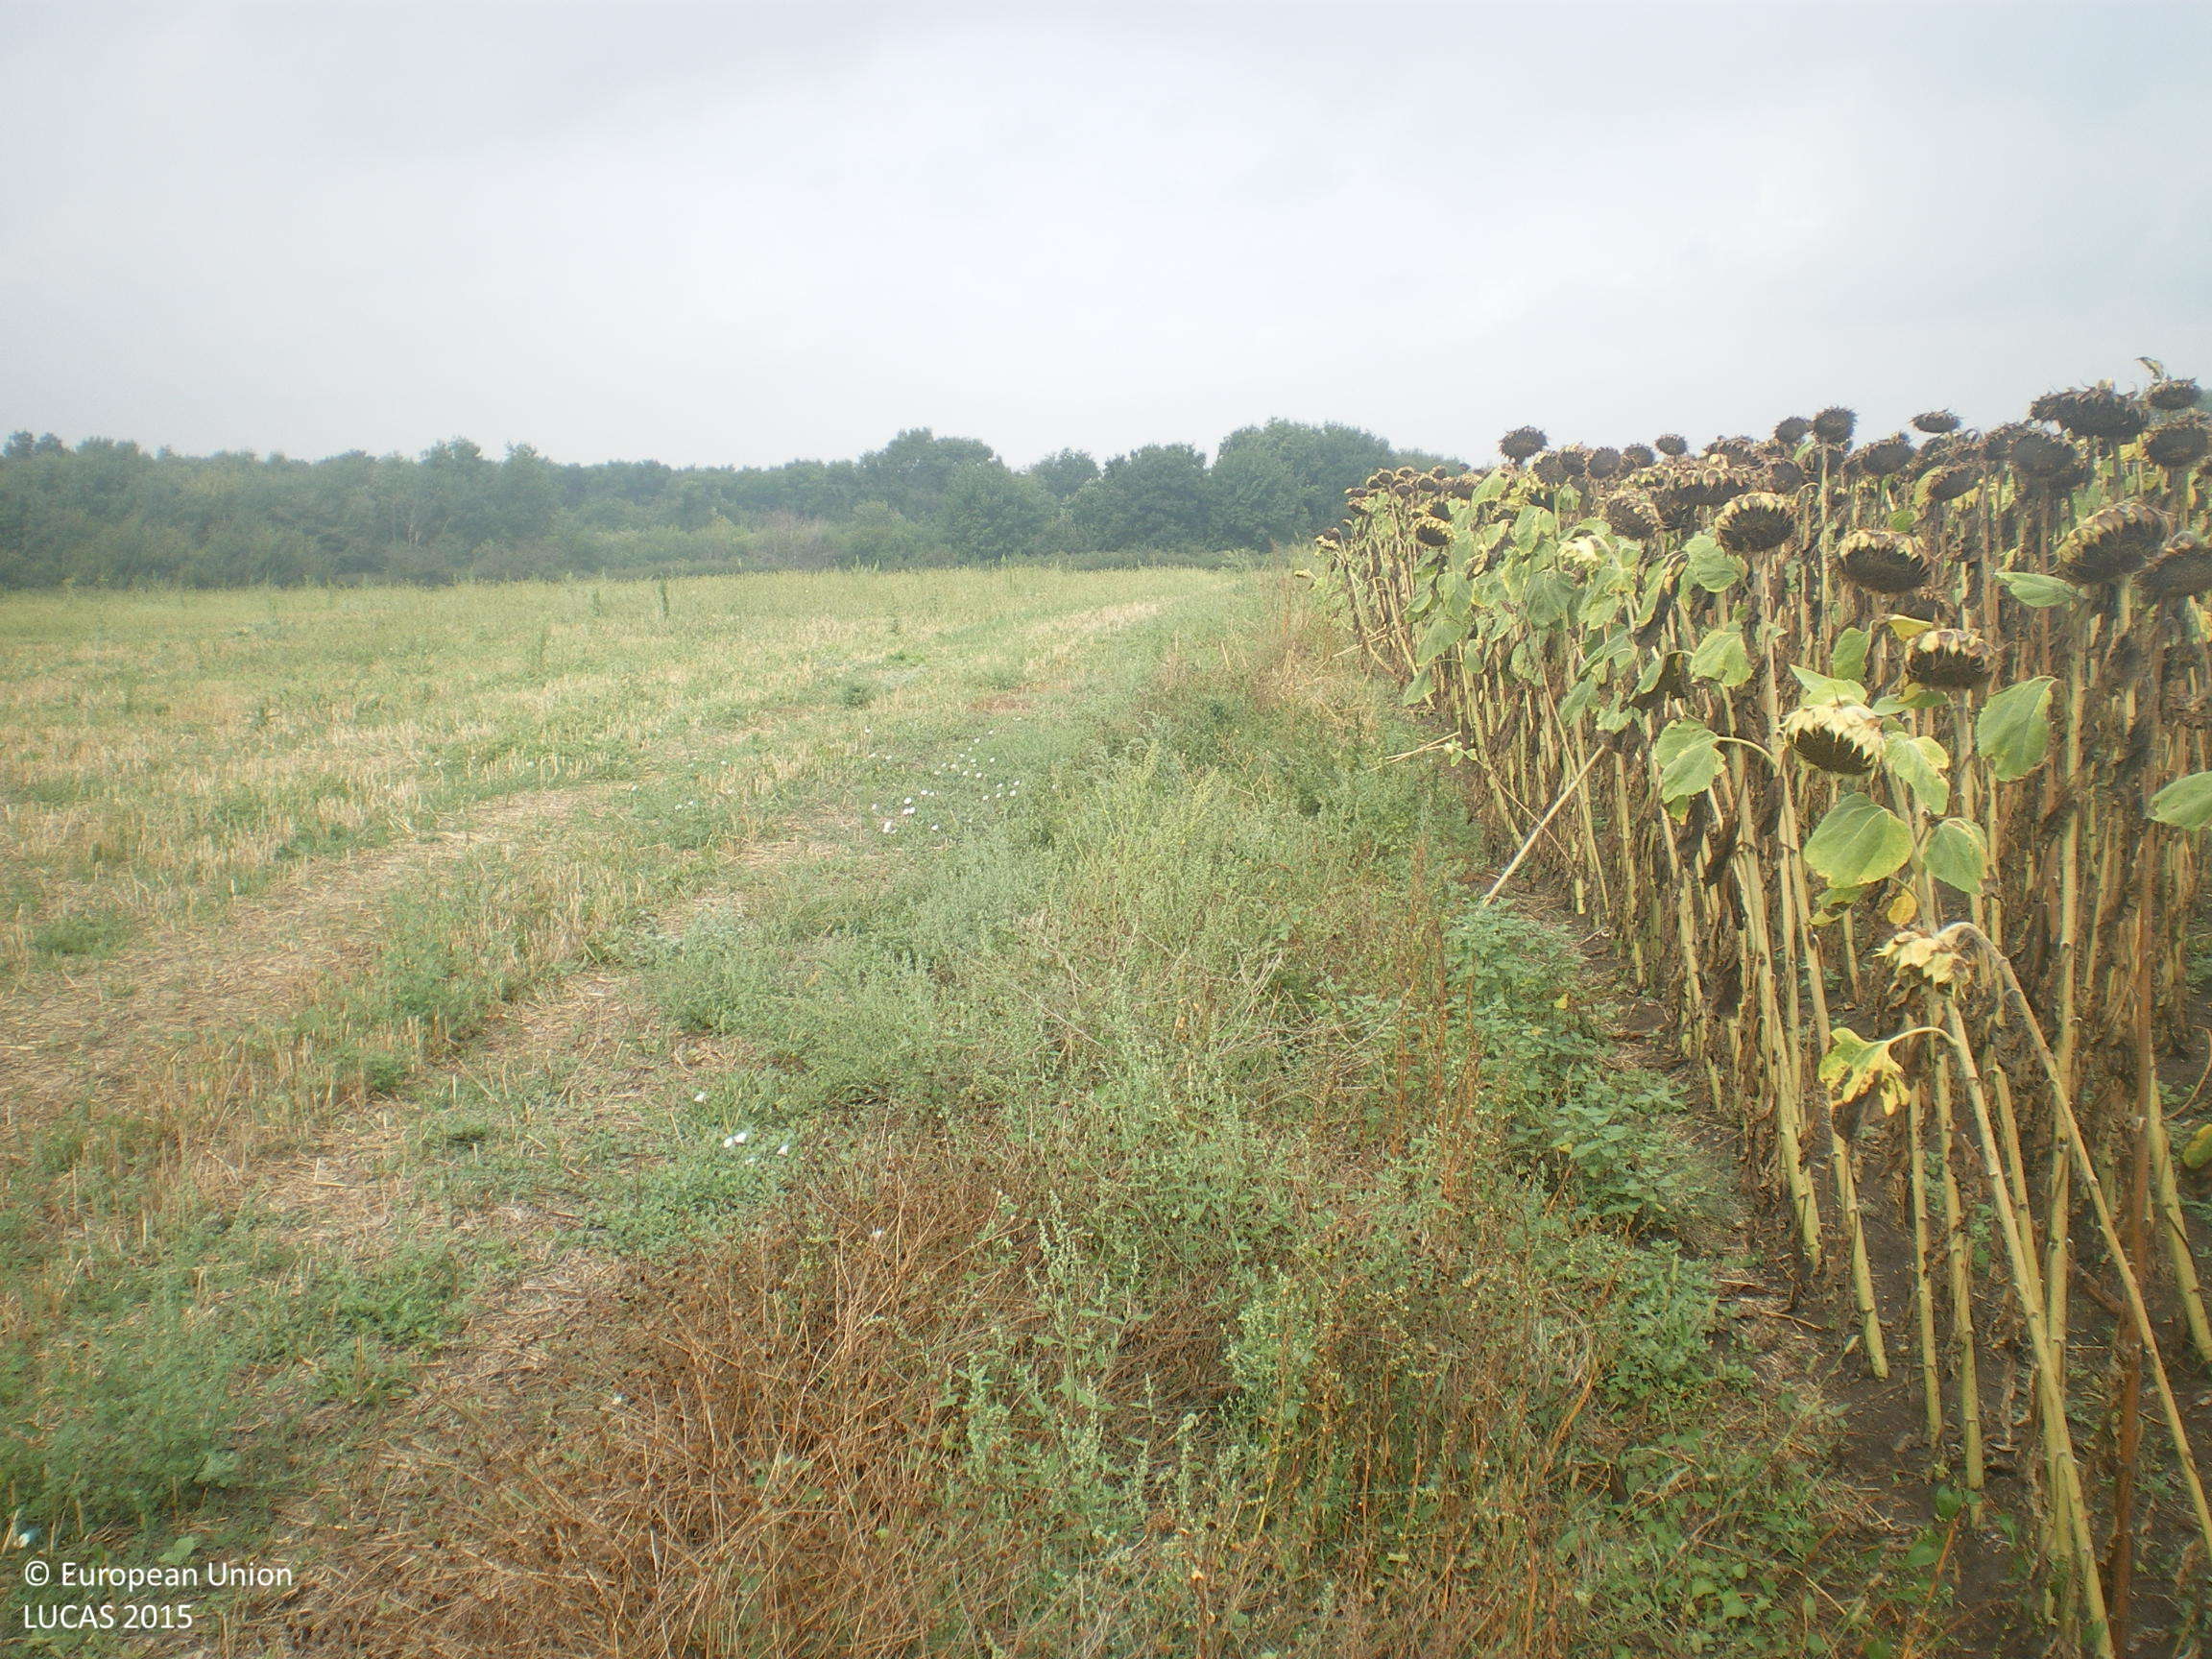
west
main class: Cropland
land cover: Sunflower
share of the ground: > 75 %
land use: Agriculture (excluding fallow land and kitchen gardens)
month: August
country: BG
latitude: 42.3236
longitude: 25.9122
